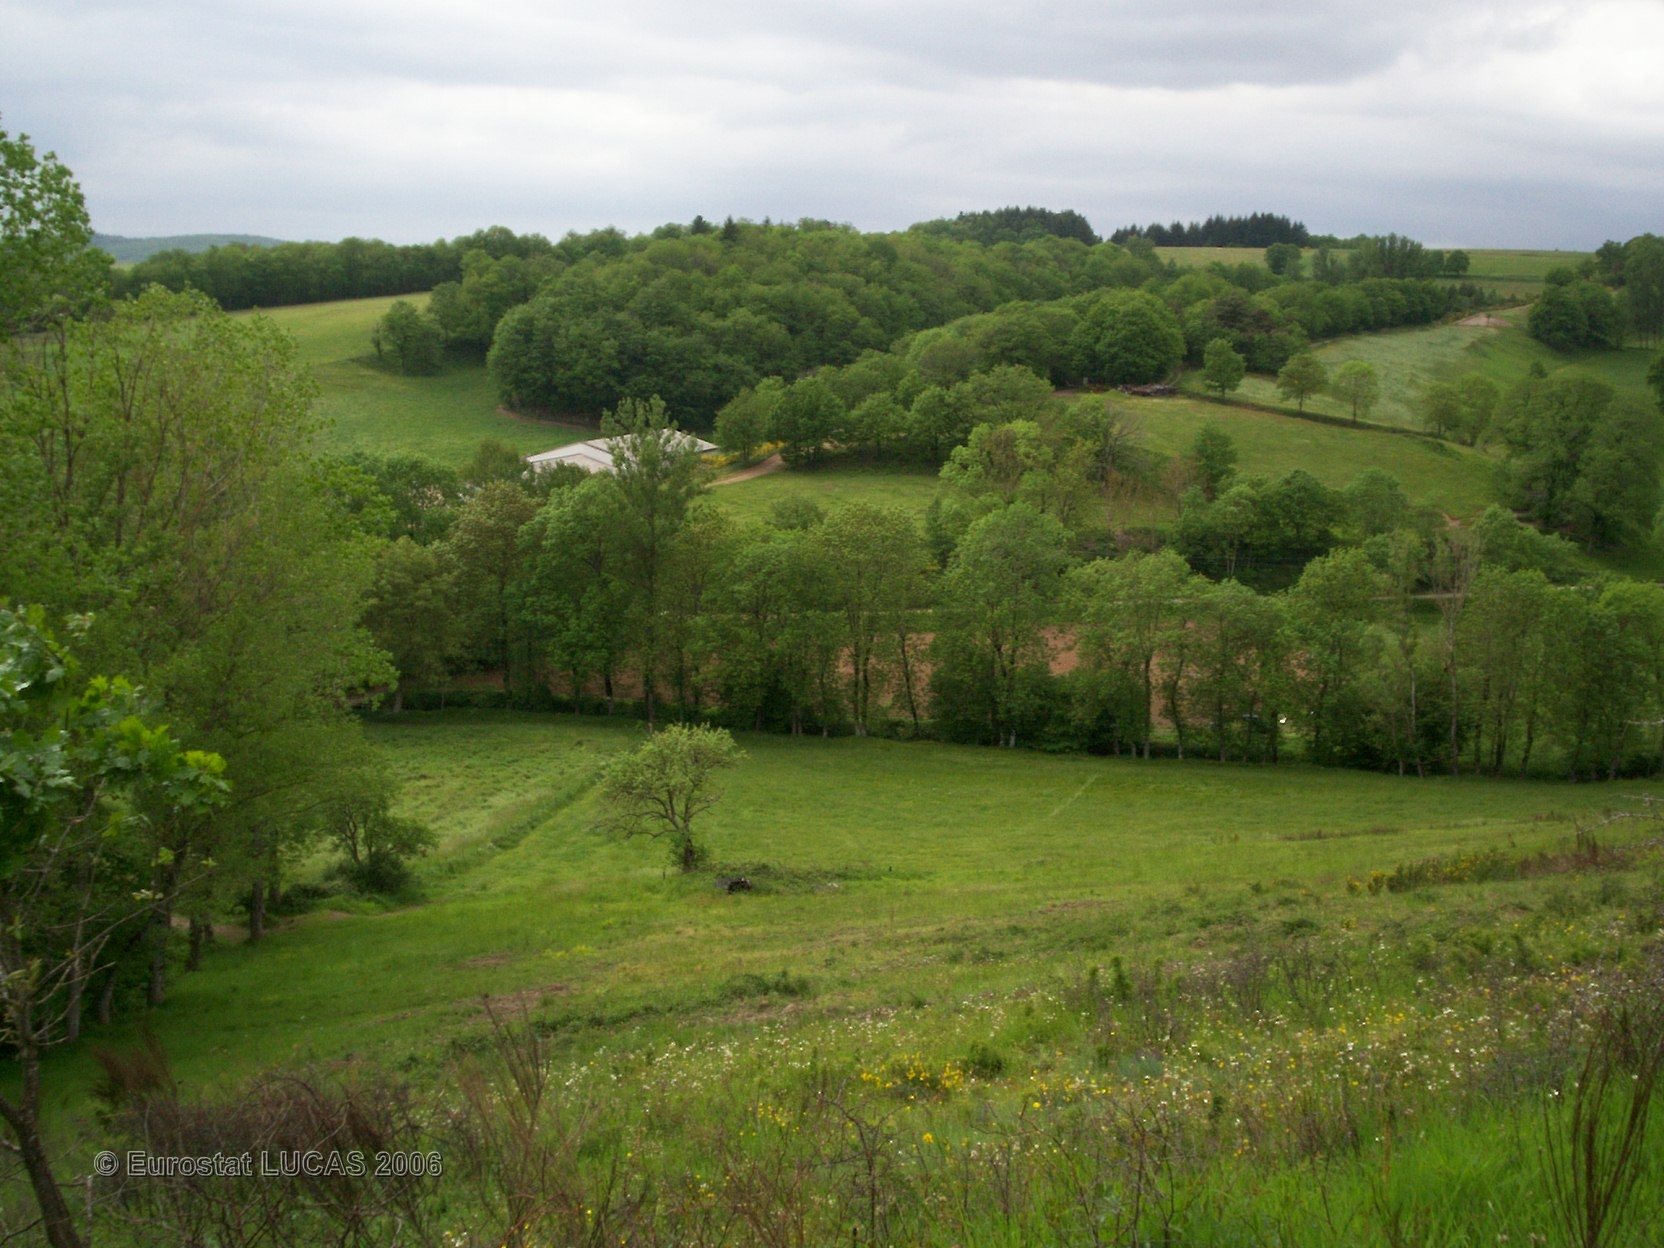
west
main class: Grassland
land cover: Grassland with sparse tree/shrub cover
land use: Agriculture (excluding fallow land and kitchen gardens)
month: May
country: FR
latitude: 43.9767
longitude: 3.3876
